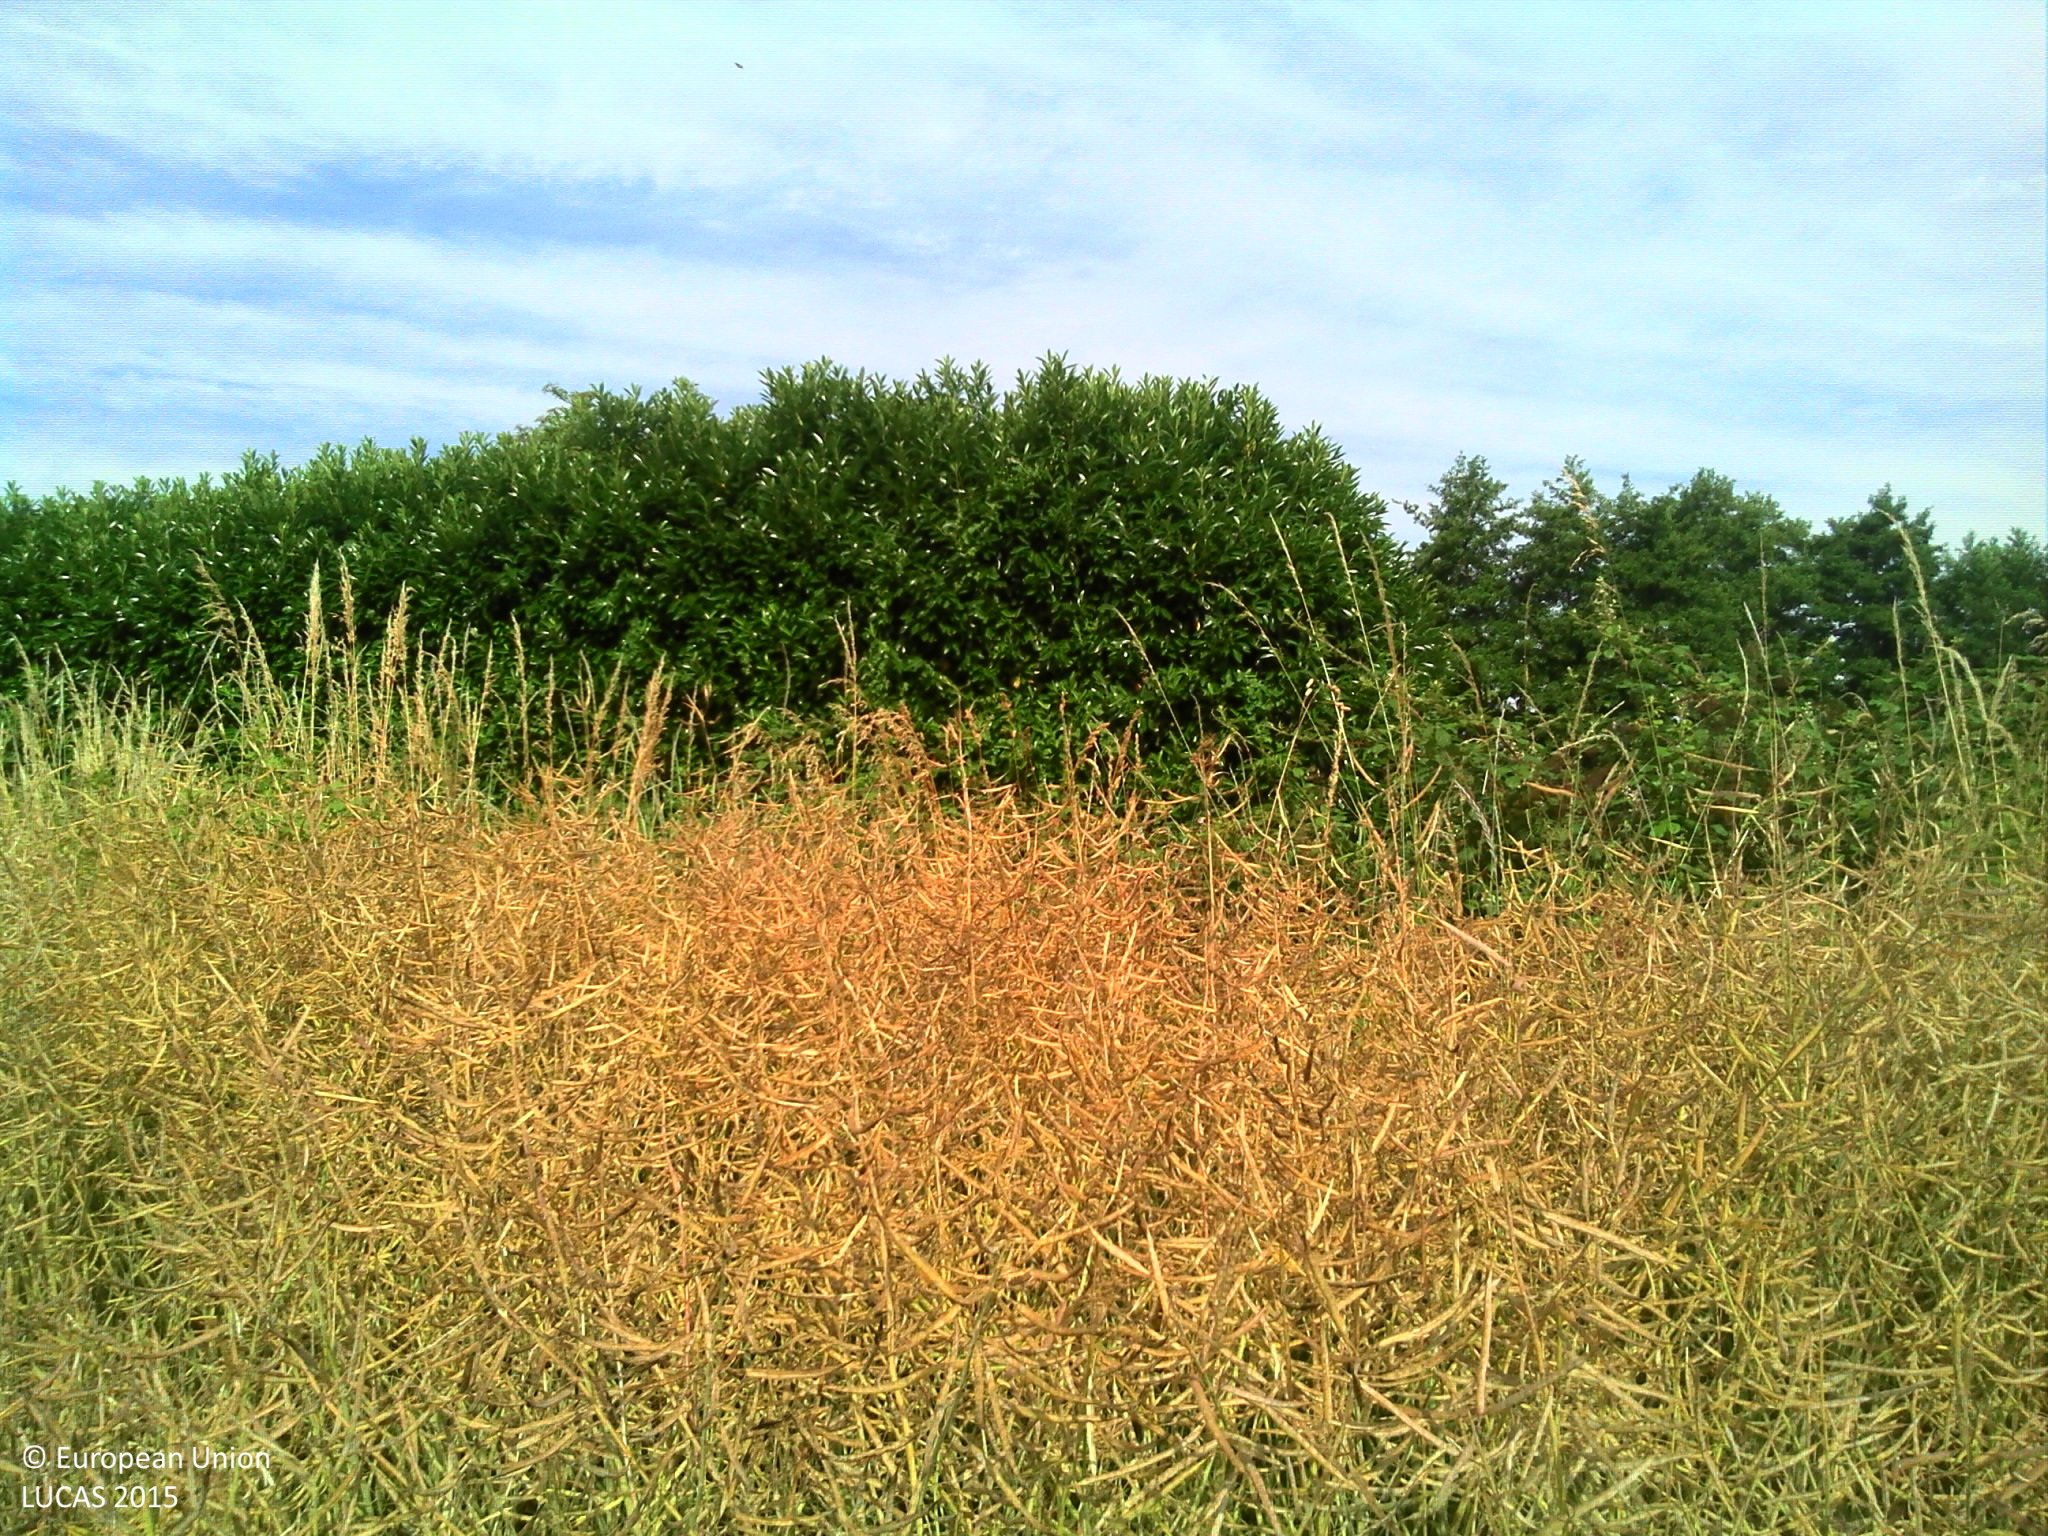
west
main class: Cropland
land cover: Rape and turnip rape
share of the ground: > 75 %
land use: Agriculture (excluding fallow land and kitchen gardens)
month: June
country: FR
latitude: 47.6693
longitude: 2.6273
